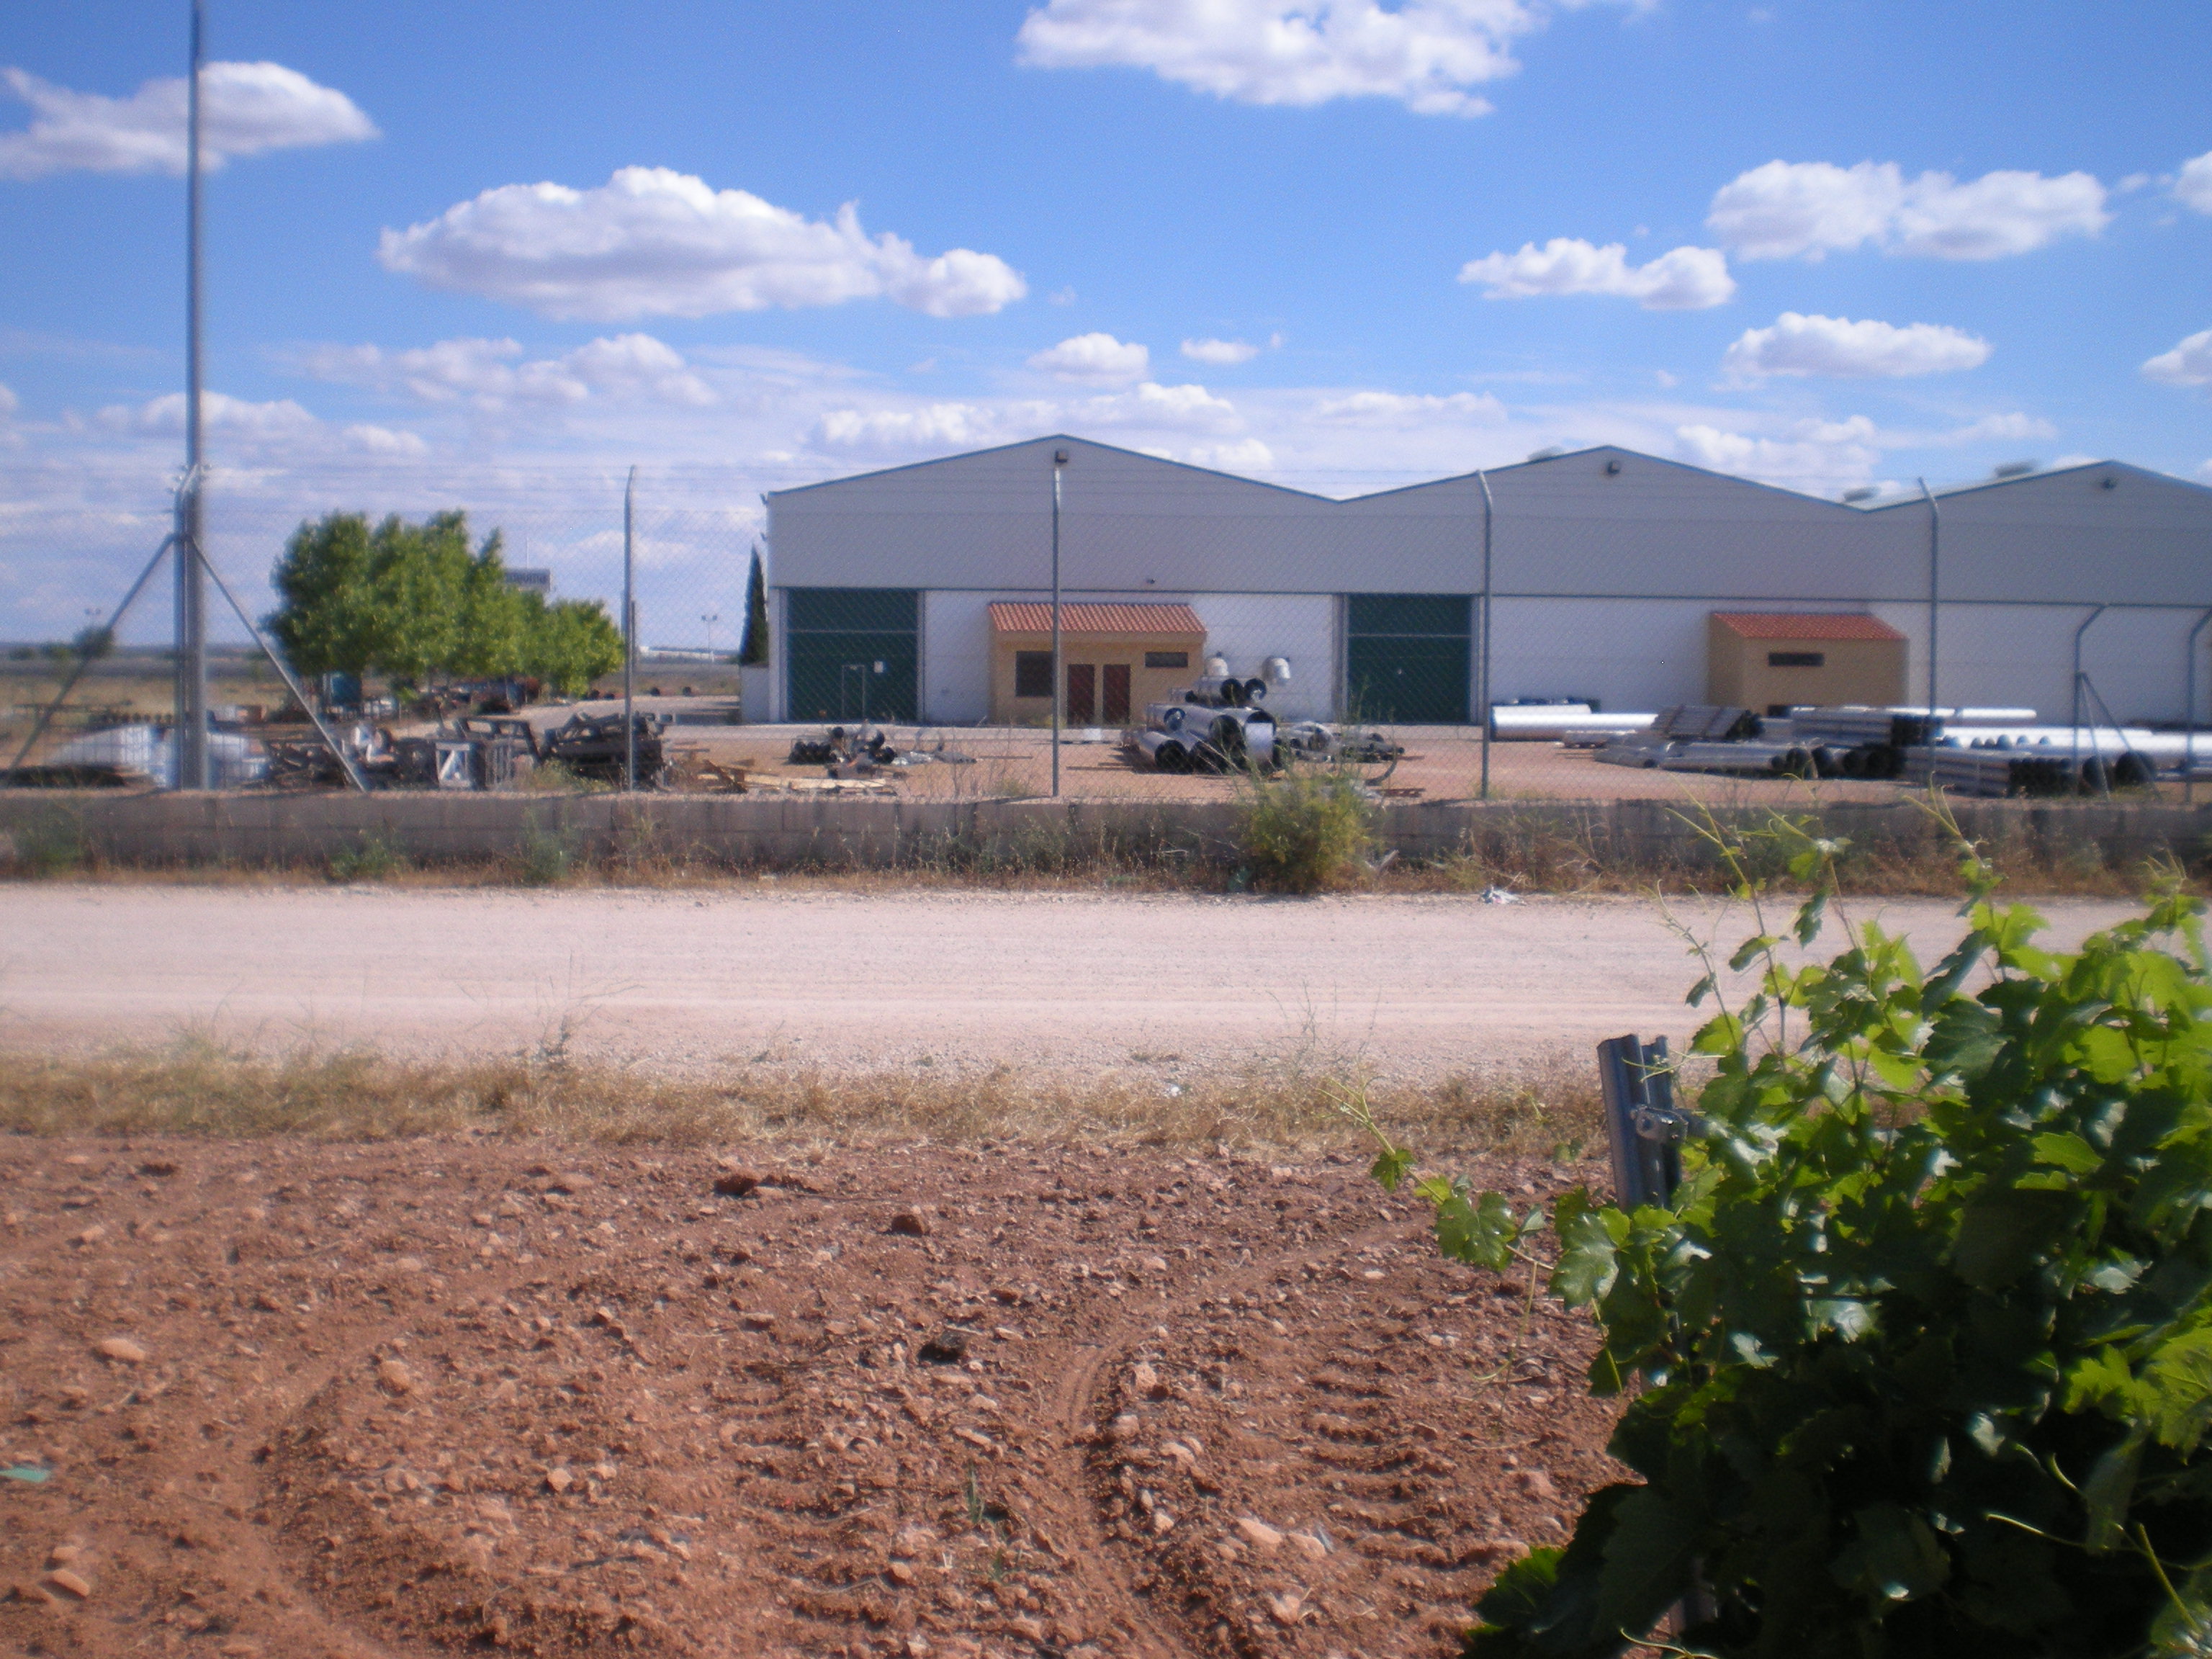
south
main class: Cropland
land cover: Vineyards
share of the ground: 10 - 25 %
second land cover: Other bare soil
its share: > 75 %
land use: Agriculture (excluding fallow land and kitchen gardens)
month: June
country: ES
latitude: 39.1623
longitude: -2.9859
